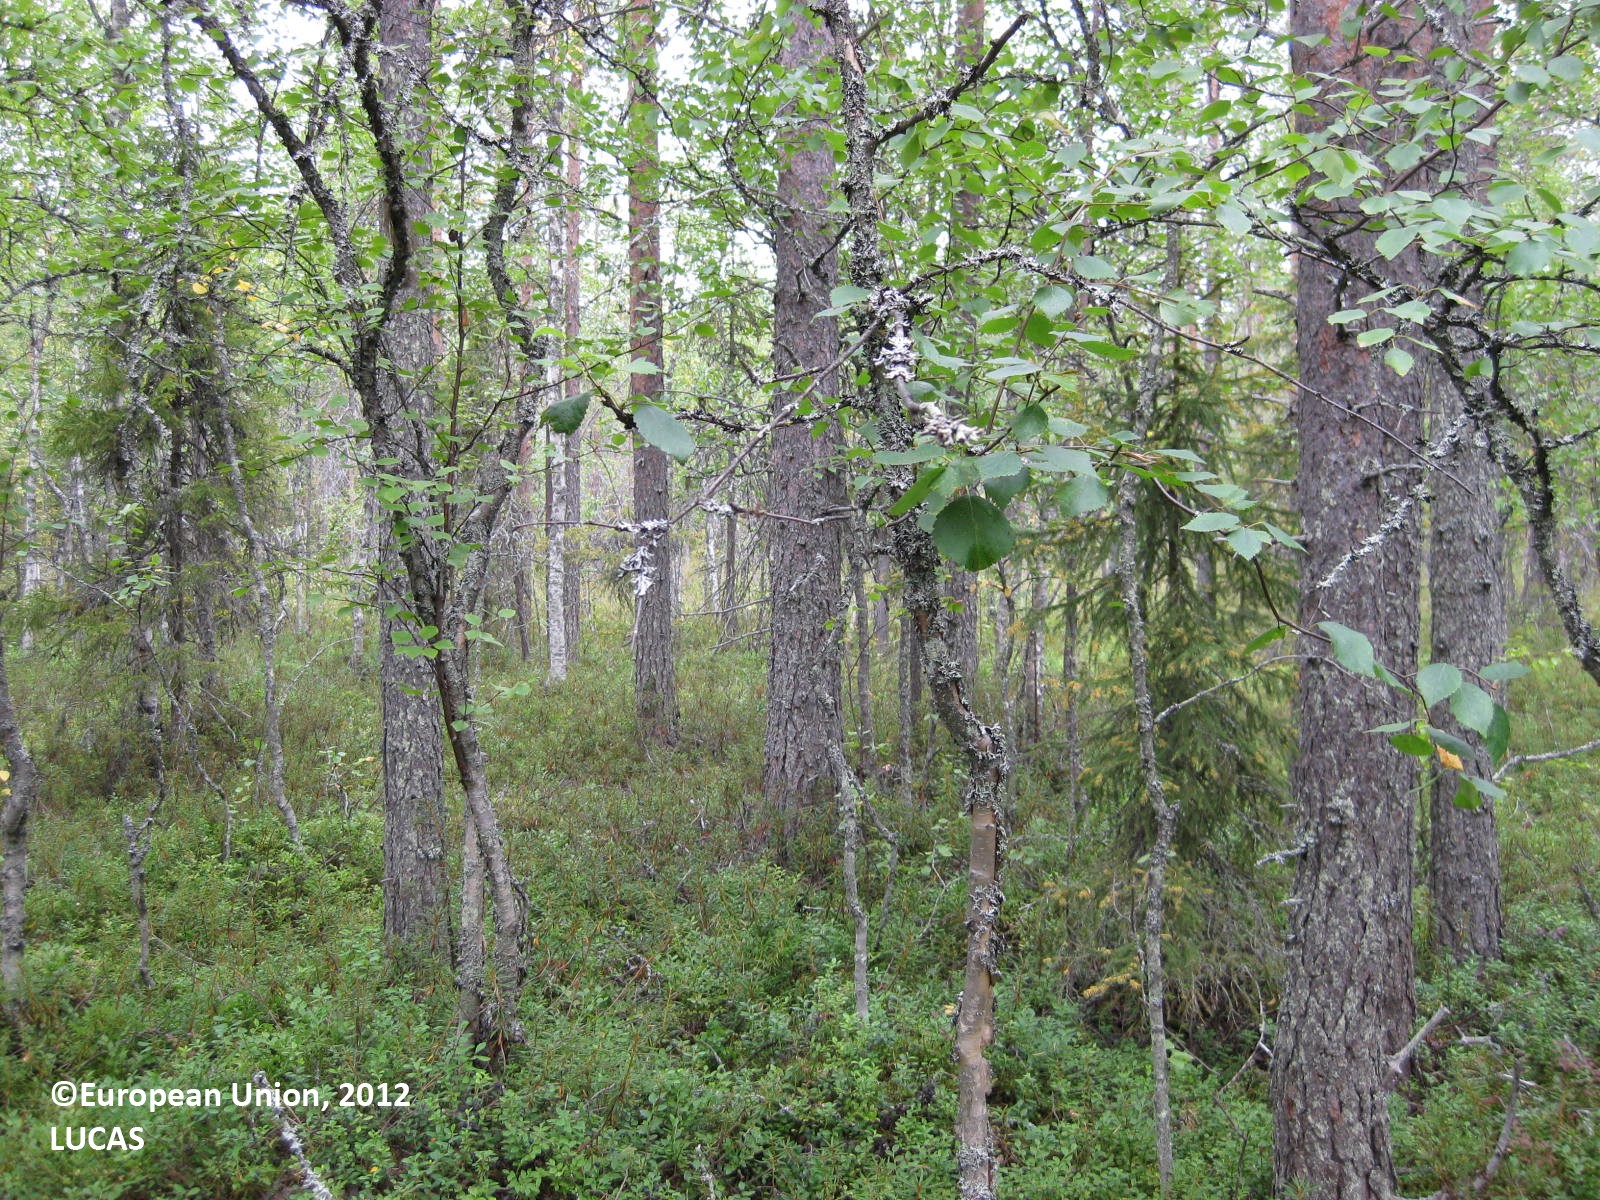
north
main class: Woodland
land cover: Pine dominated mixed woodland
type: boreal forest
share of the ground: 50 - 75 %
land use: Forestry
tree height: > 5 m
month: August
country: FI
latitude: 66.2839
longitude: 28.8556
